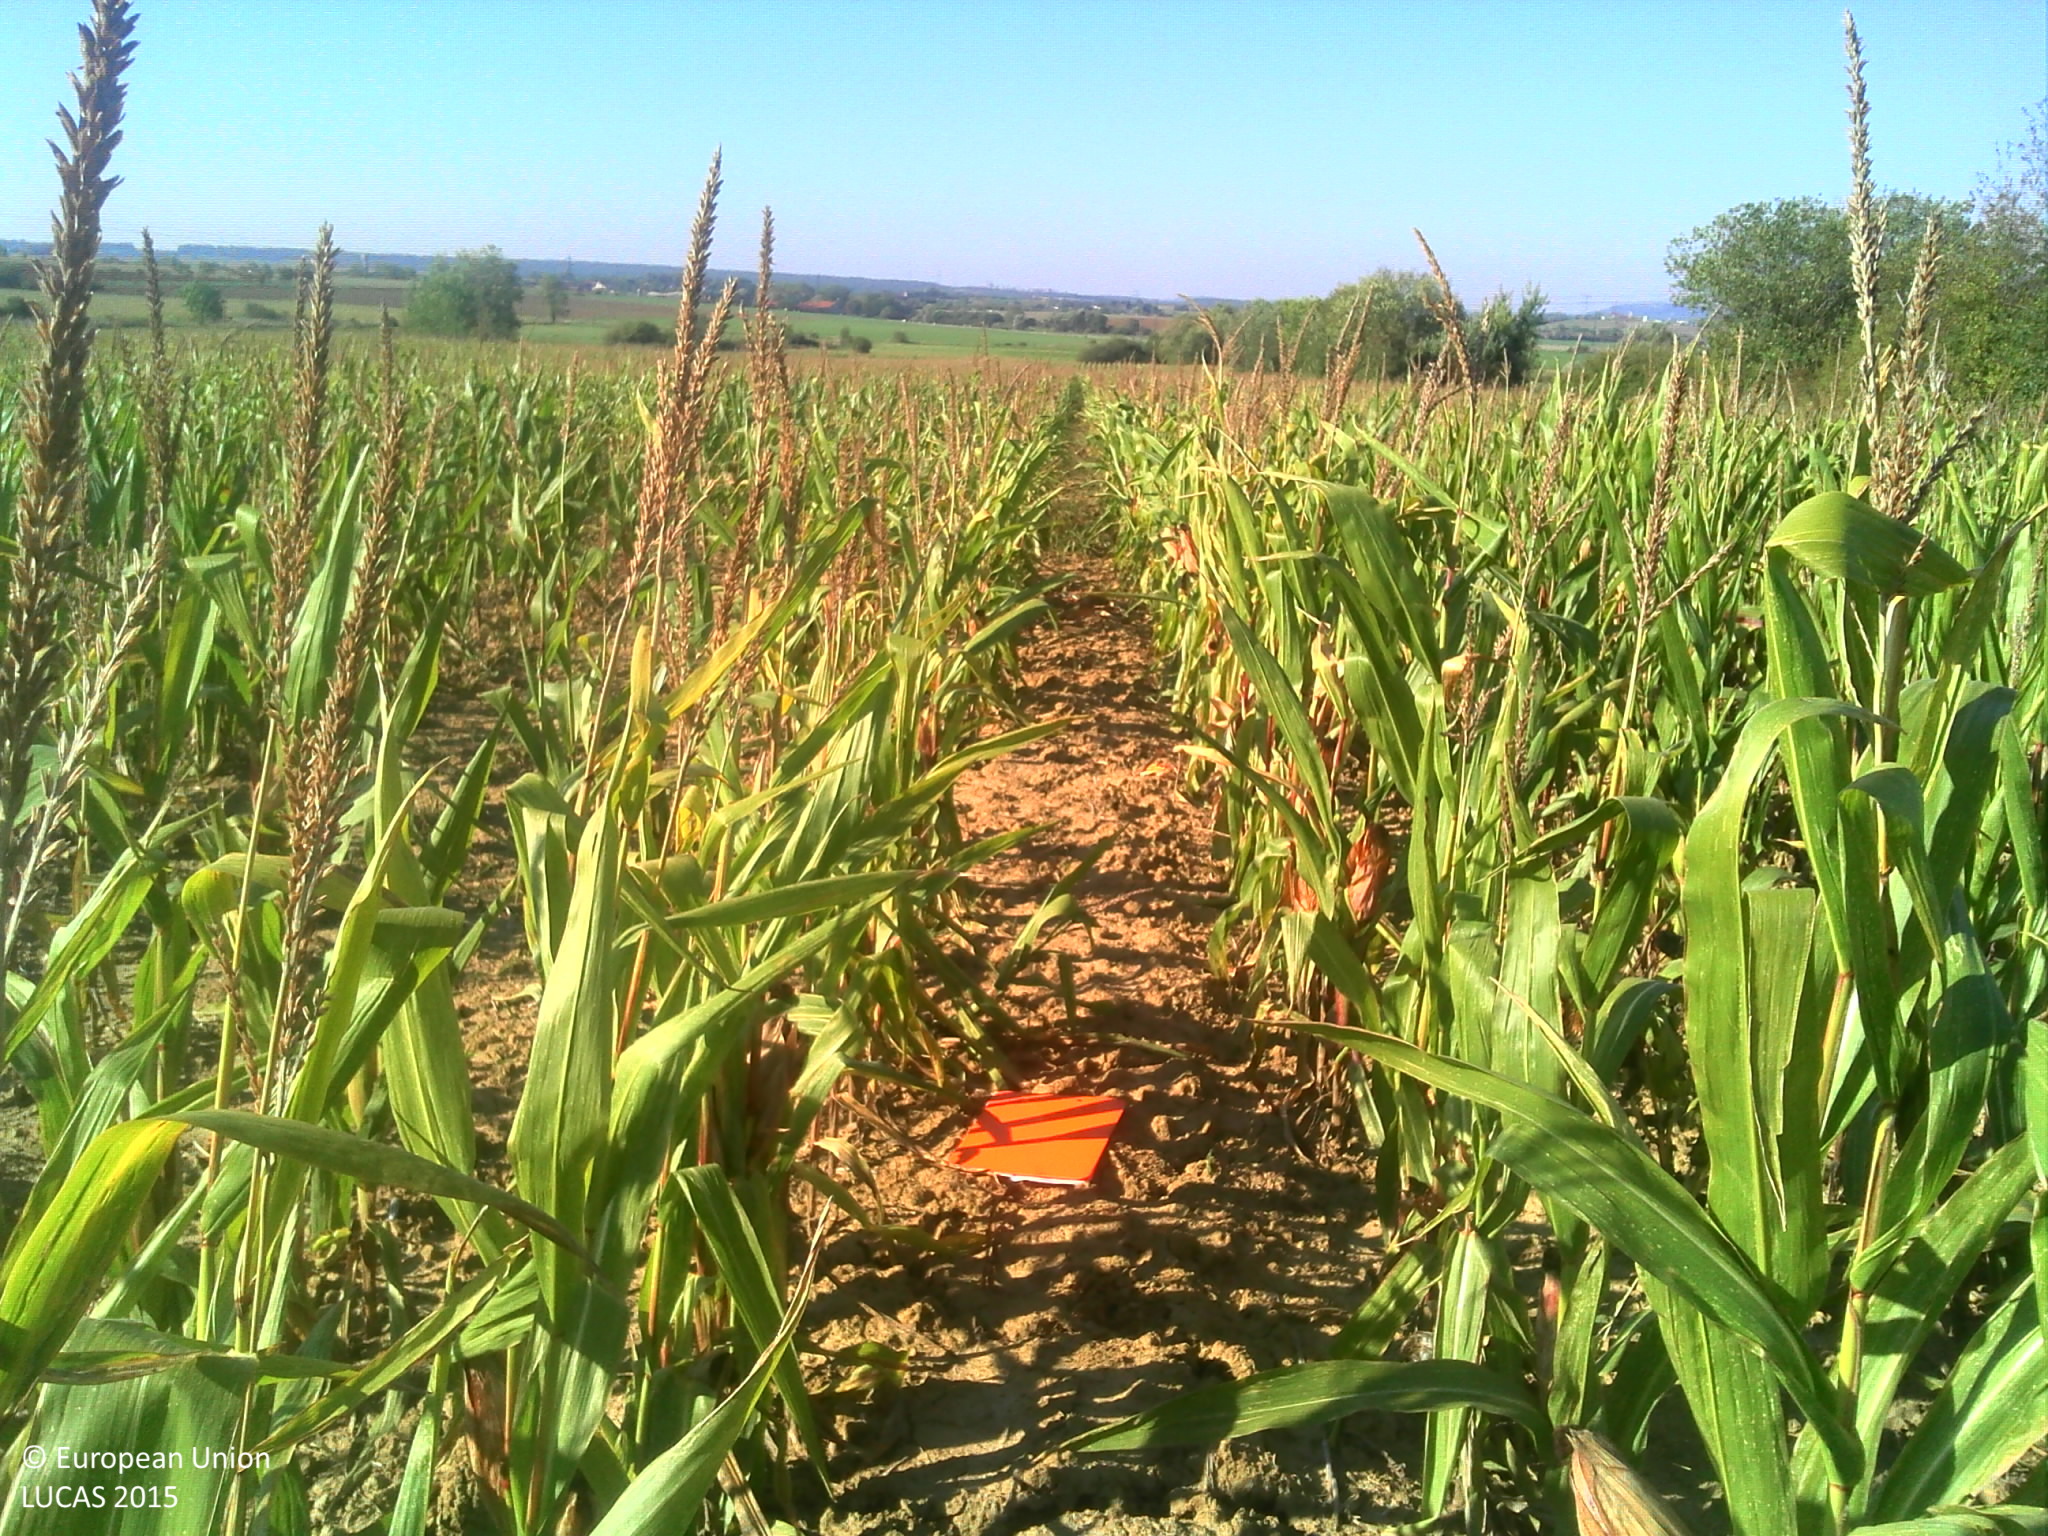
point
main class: Cropland
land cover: Maize
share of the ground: > 75 %
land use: Agriculture (excluding fallow land and kitchen gardens)
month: October
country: FR
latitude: 48.6287
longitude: 6.2689
